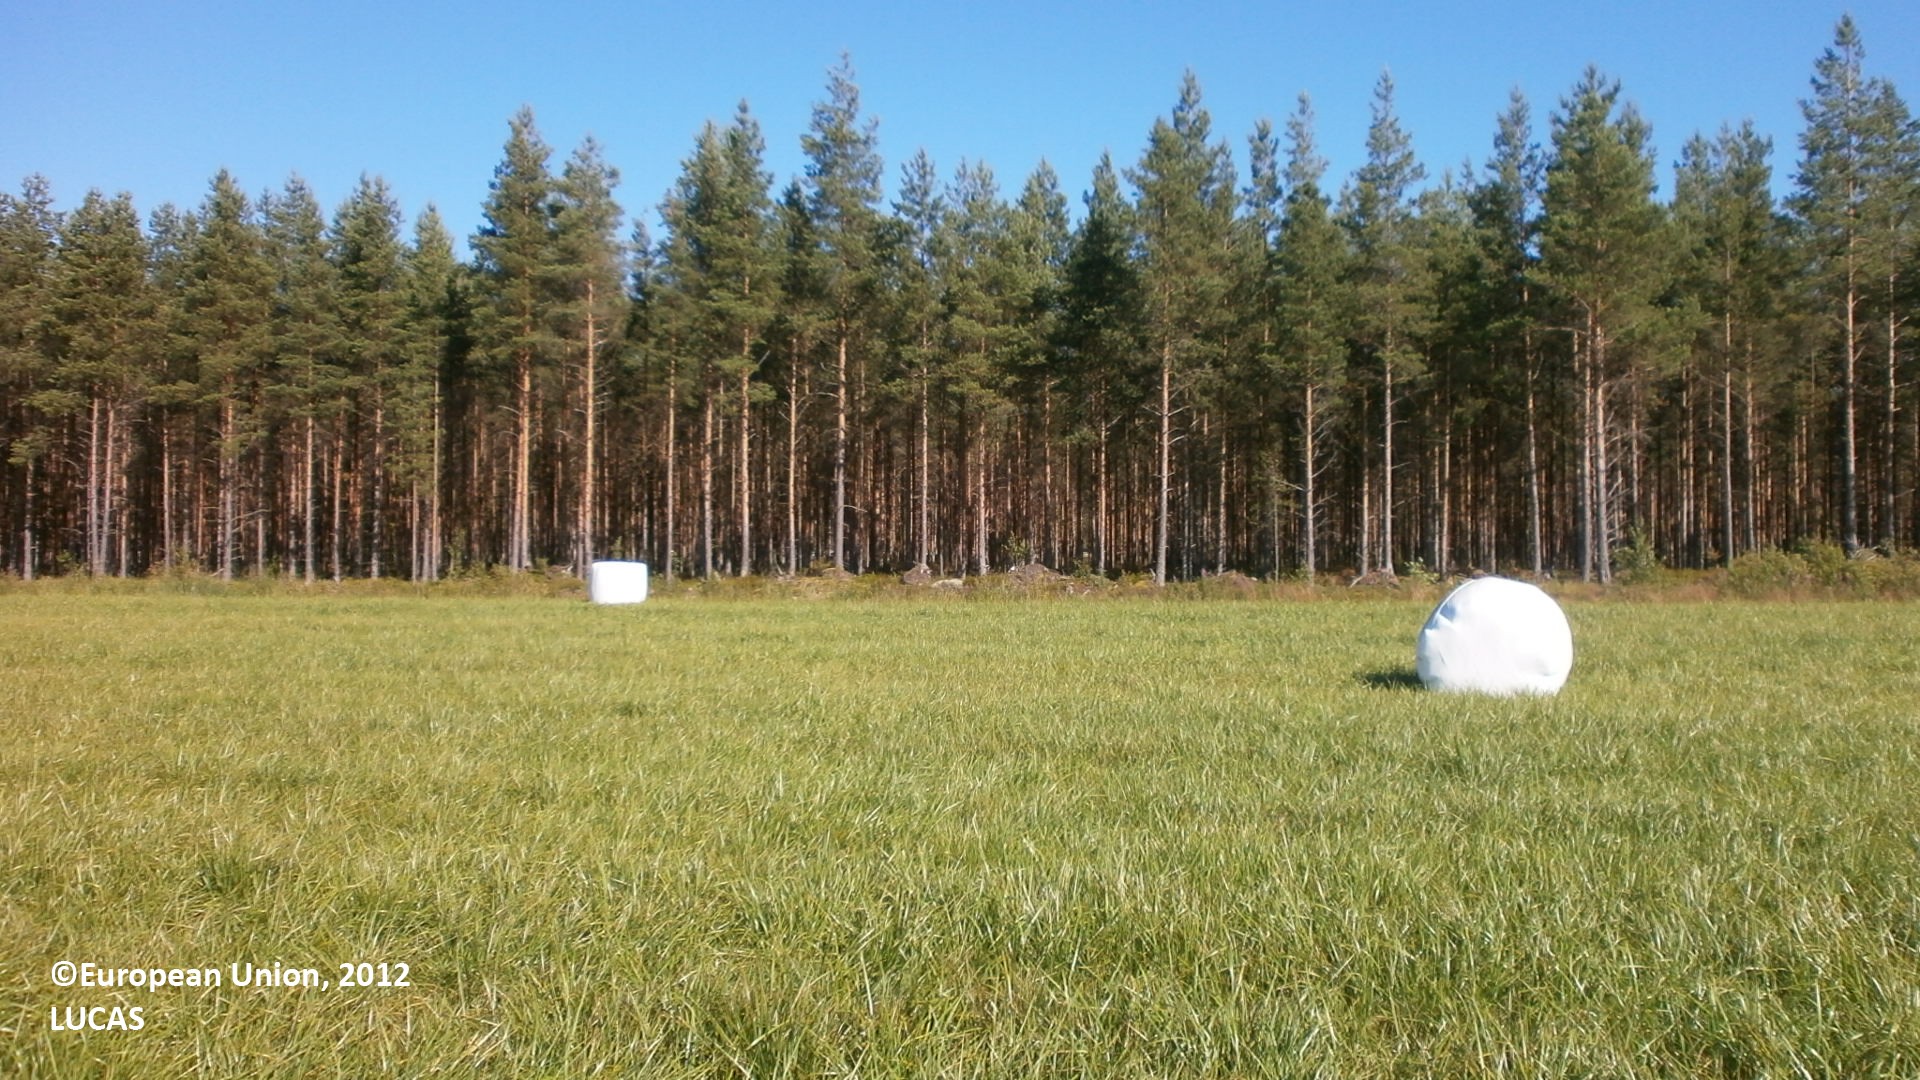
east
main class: Cropland
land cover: Temporary grasslands
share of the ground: > 75 %
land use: Agriculture (excluding fallow land and kitchen gardens)
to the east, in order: Temporary grasslands; Shruby margins; Ditches and canals; Pine dominated coniferous woodland; Pine dominated mixed woodland; Ditches and canals; Pine dominated coniferous woodland; Tracks; Pine dominated coniferous woodland
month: July
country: FI
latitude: 64.1649
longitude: 23.9455
